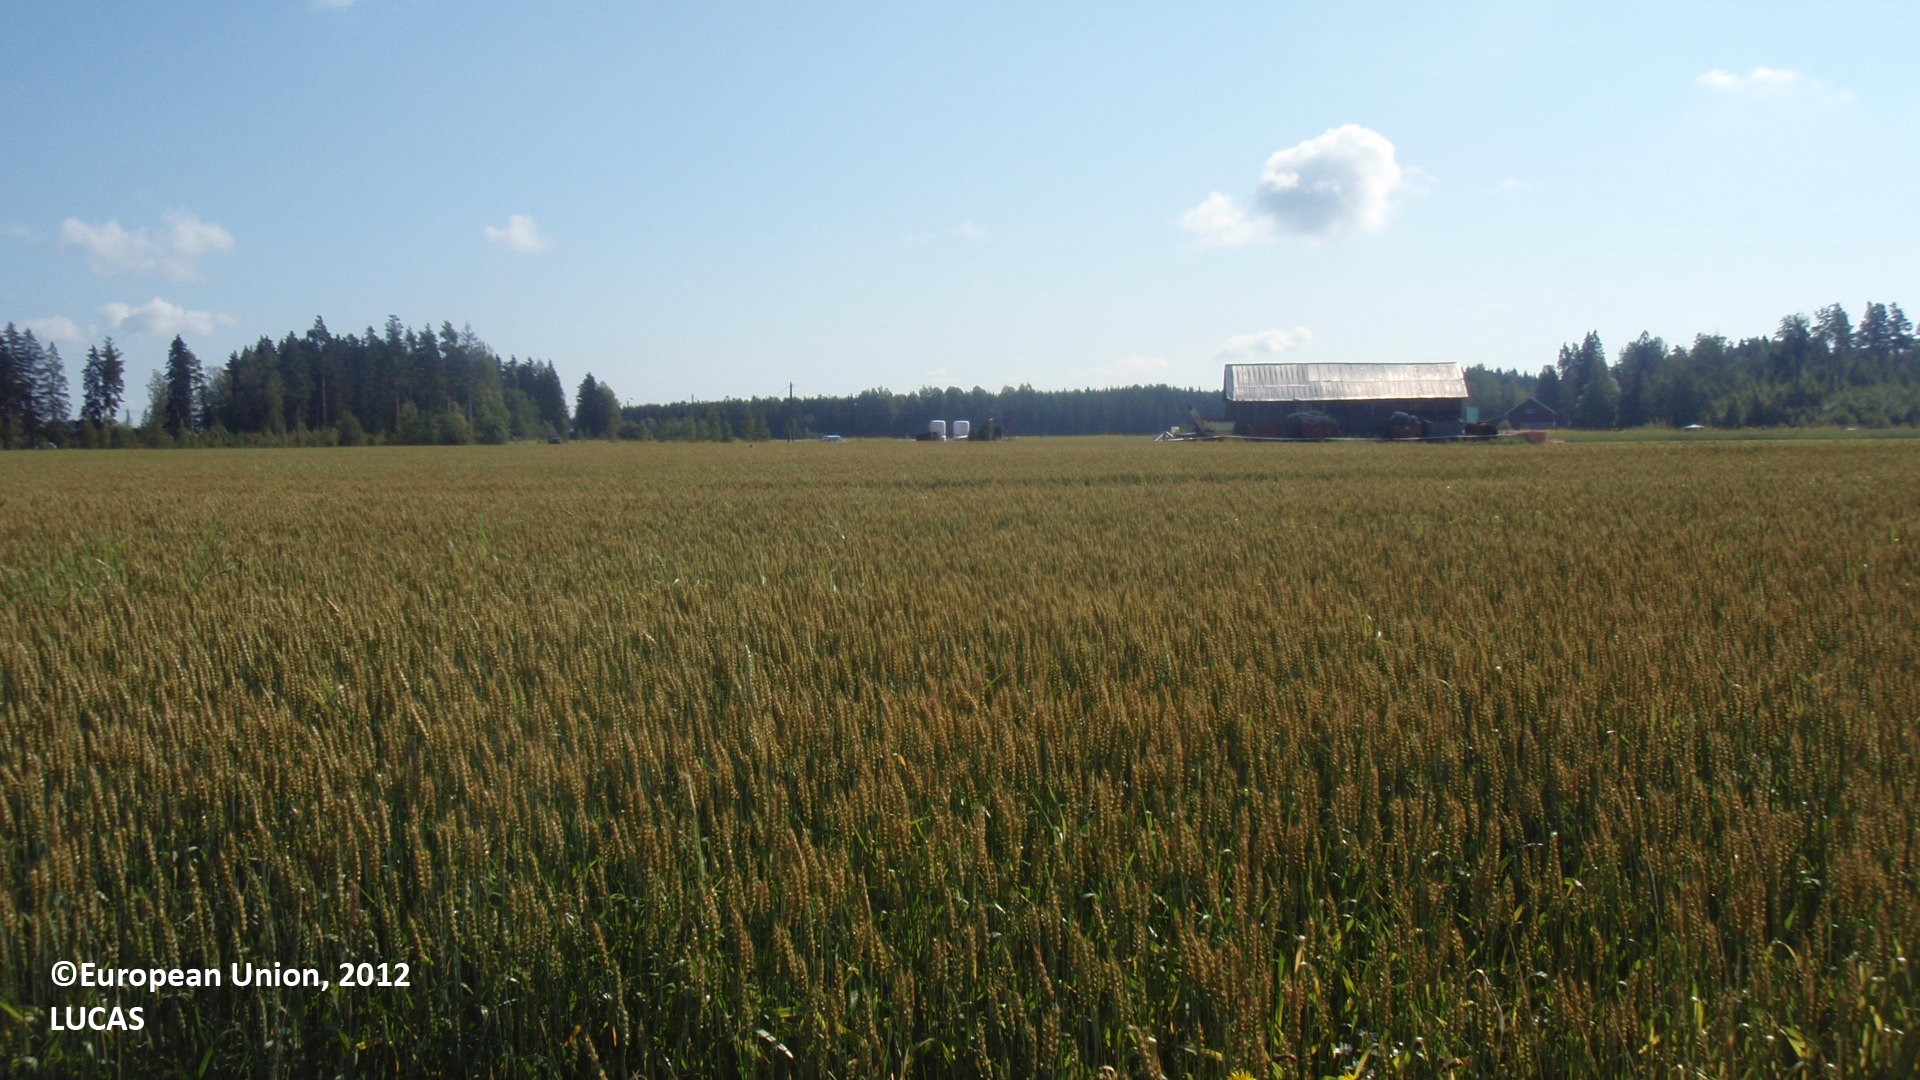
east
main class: Shrubland
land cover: Shrubland with sparse tree cover
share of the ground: > 75 %
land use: Agriculture (excluding fallow land and kitchen gardens)
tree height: < 5 m
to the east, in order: Shrubland with sparse tree cover; Ditches and canals; Common wheat; Ditches and canals; Shrubland with sparse tree cover; Artificial constructions in urban areas; Grassland with sparse tree/shrub cover; Common wheat
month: August
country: FI
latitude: 60.7587
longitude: 26.7324
